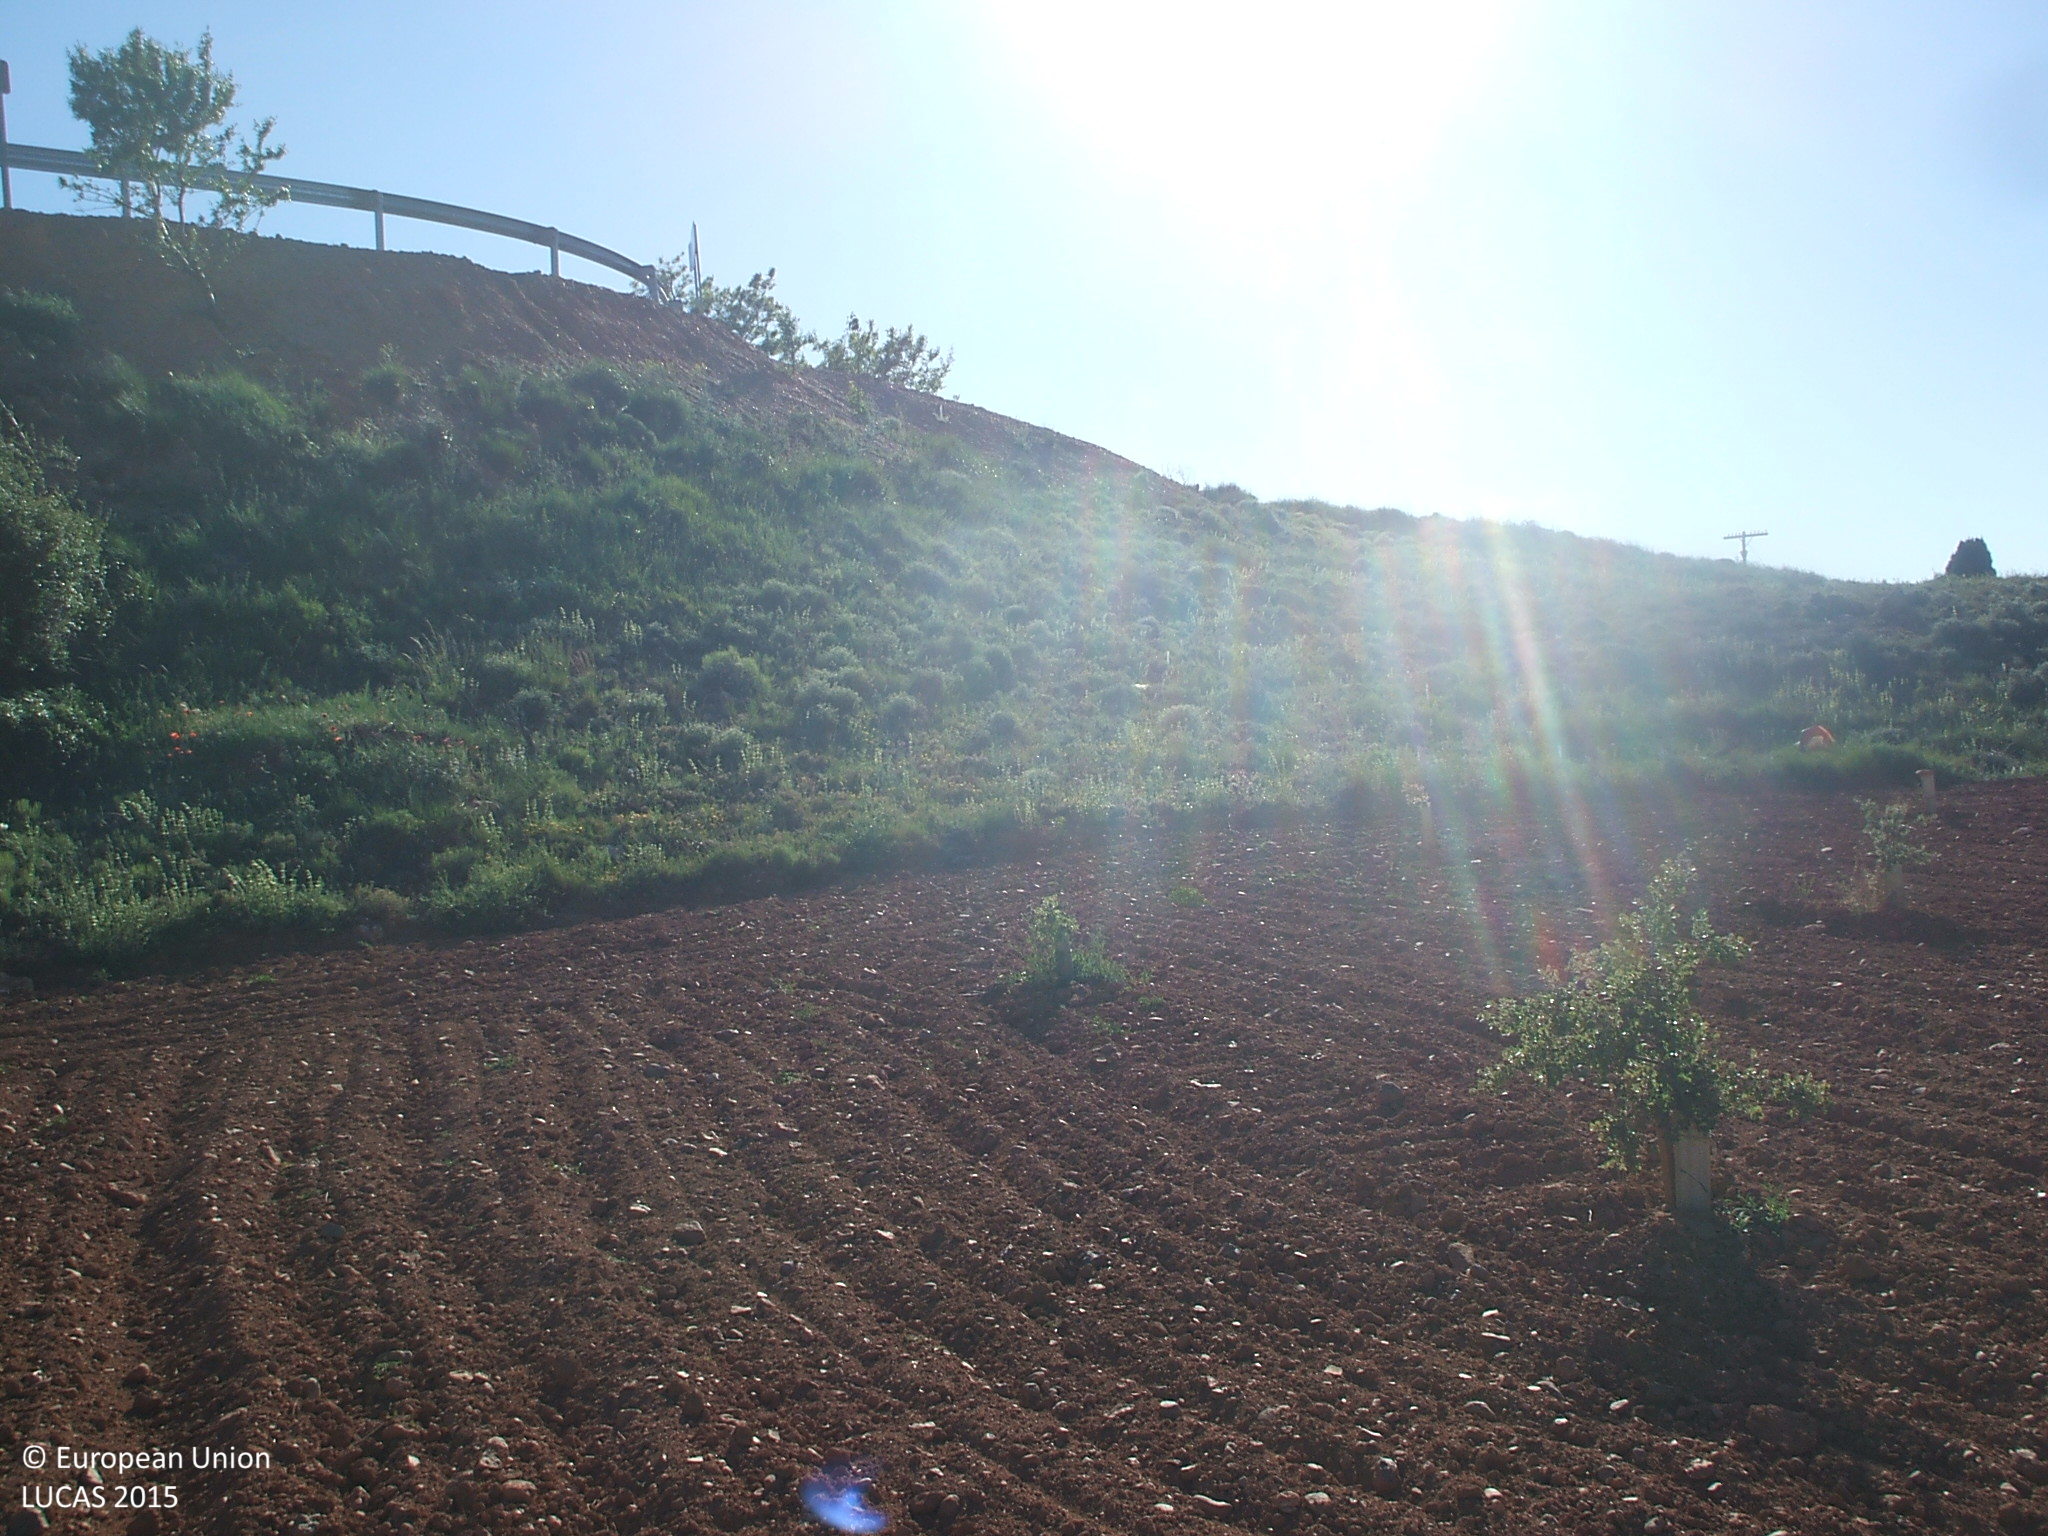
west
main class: Woodland
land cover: Broadleaved woodland
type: broadleaved evergreen forest
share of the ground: 10 - 25 %
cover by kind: unconsolidated bare surface 85 %, broadleaved forest trees 15 %
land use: Forestry
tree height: < 5 m
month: May
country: ES
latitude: 40.1136
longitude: -0.7413
